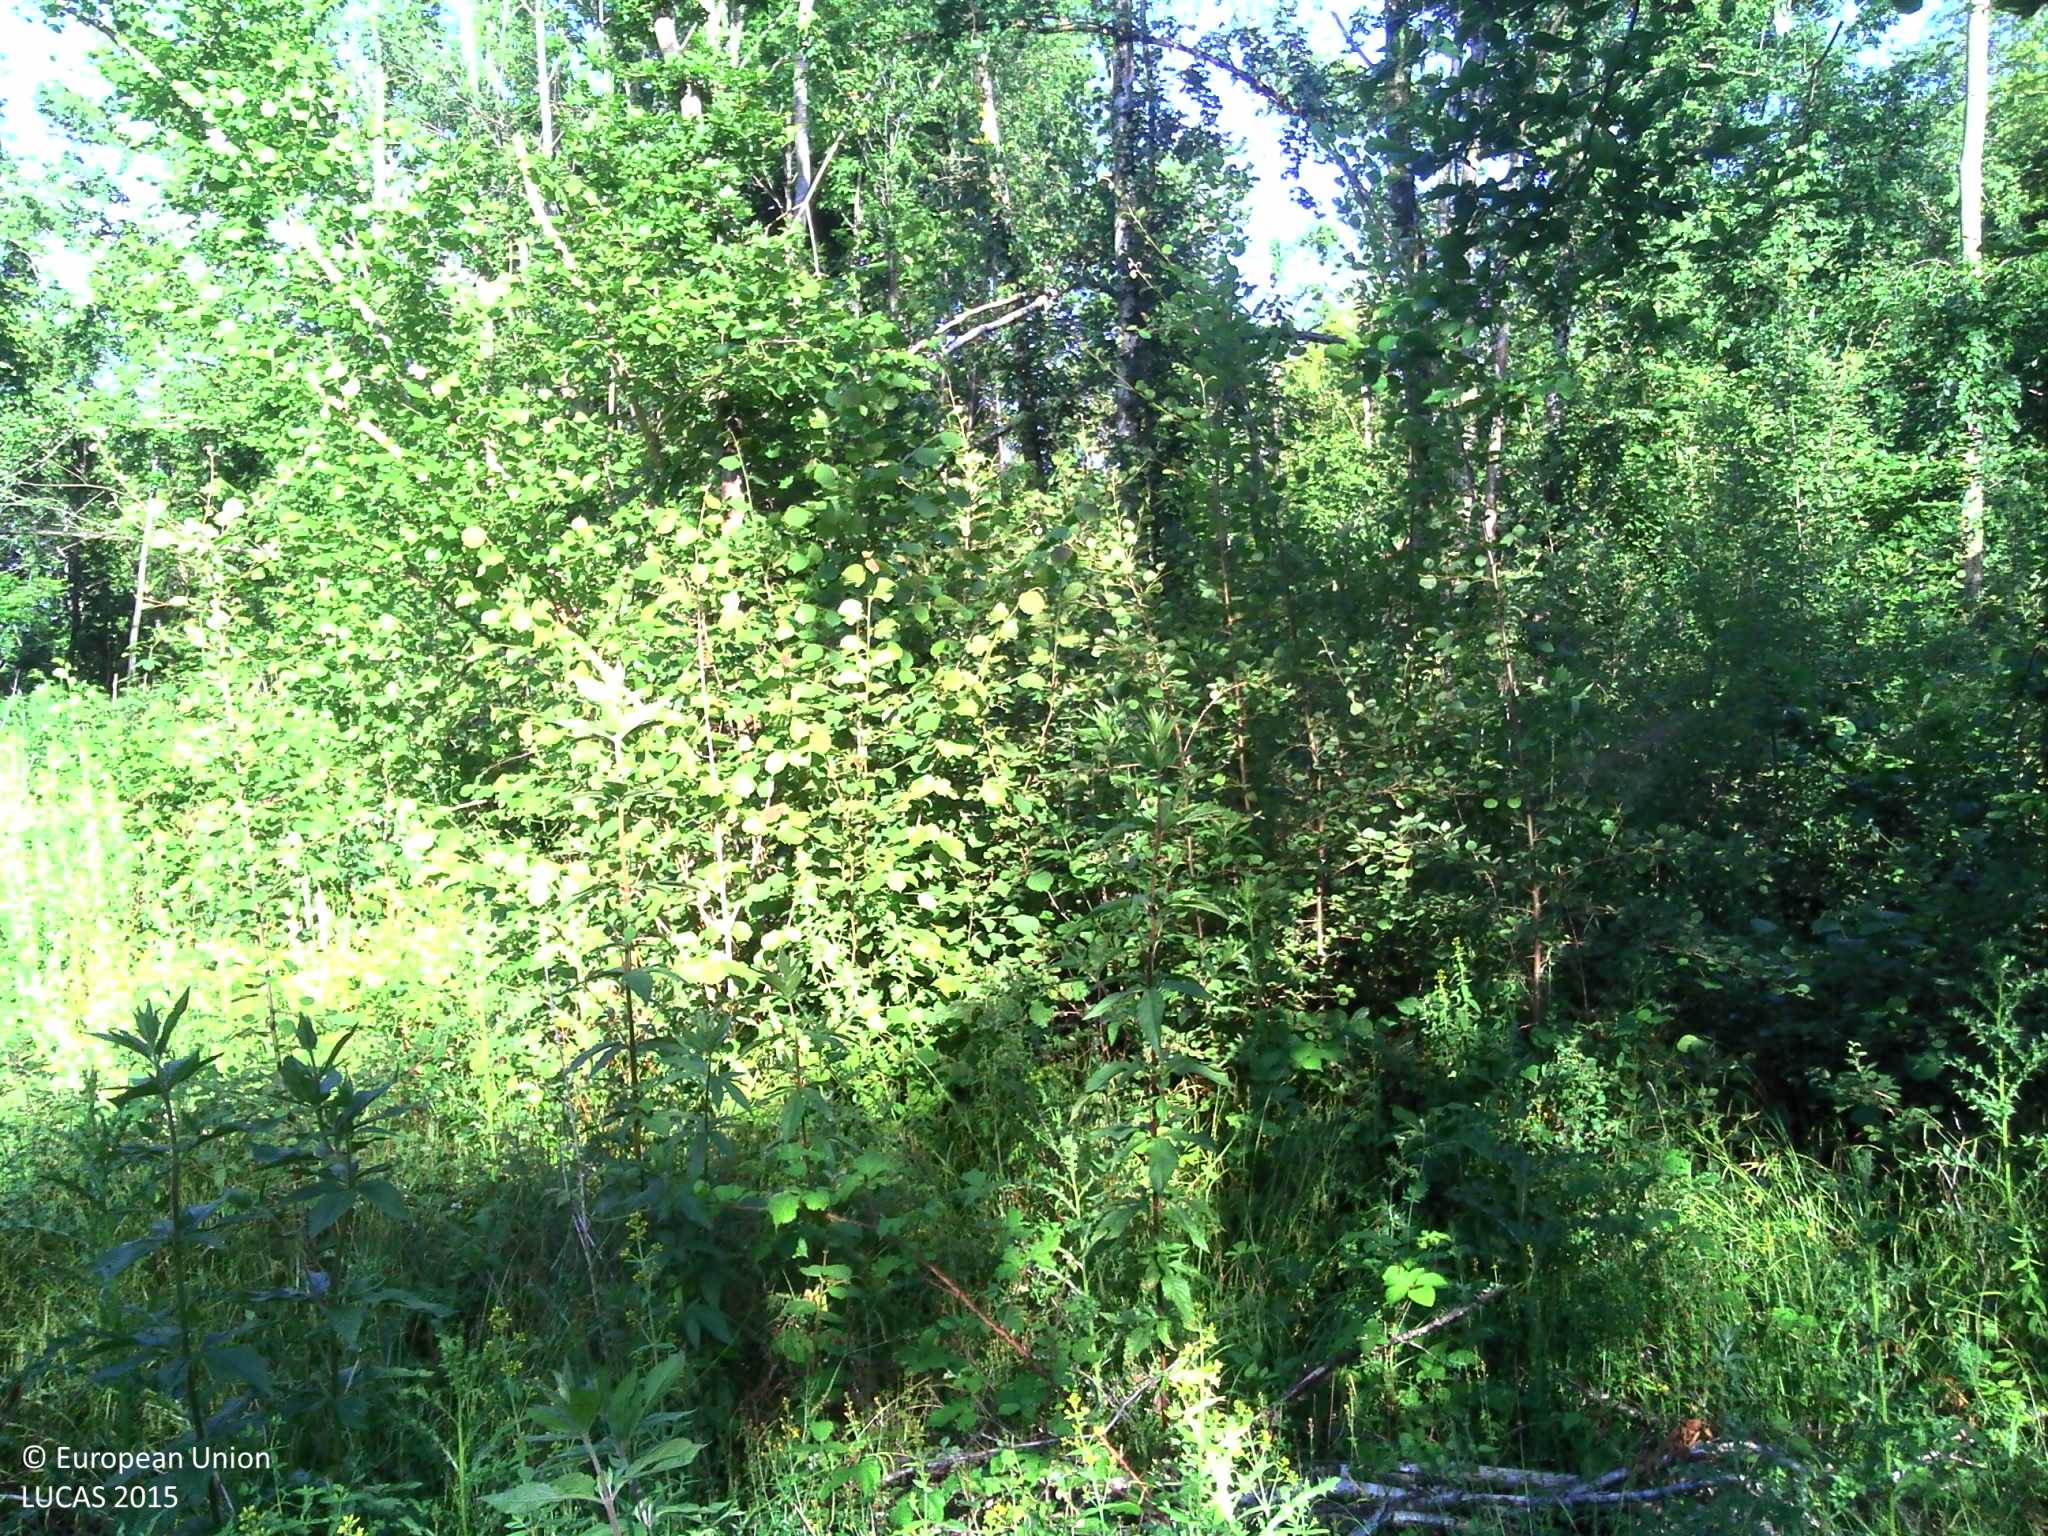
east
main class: Woodland
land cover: Broadleaved woodland
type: acidophilous oak and oak-birch forest
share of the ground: > 75 %
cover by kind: broadleaved forest trees 95 %, lichens and mosses 5 %
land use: Forestry
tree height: > 5 m
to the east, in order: Broadleaved woodland; Lucerne
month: June
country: FR
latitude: 48.5452
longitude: 0.1785
